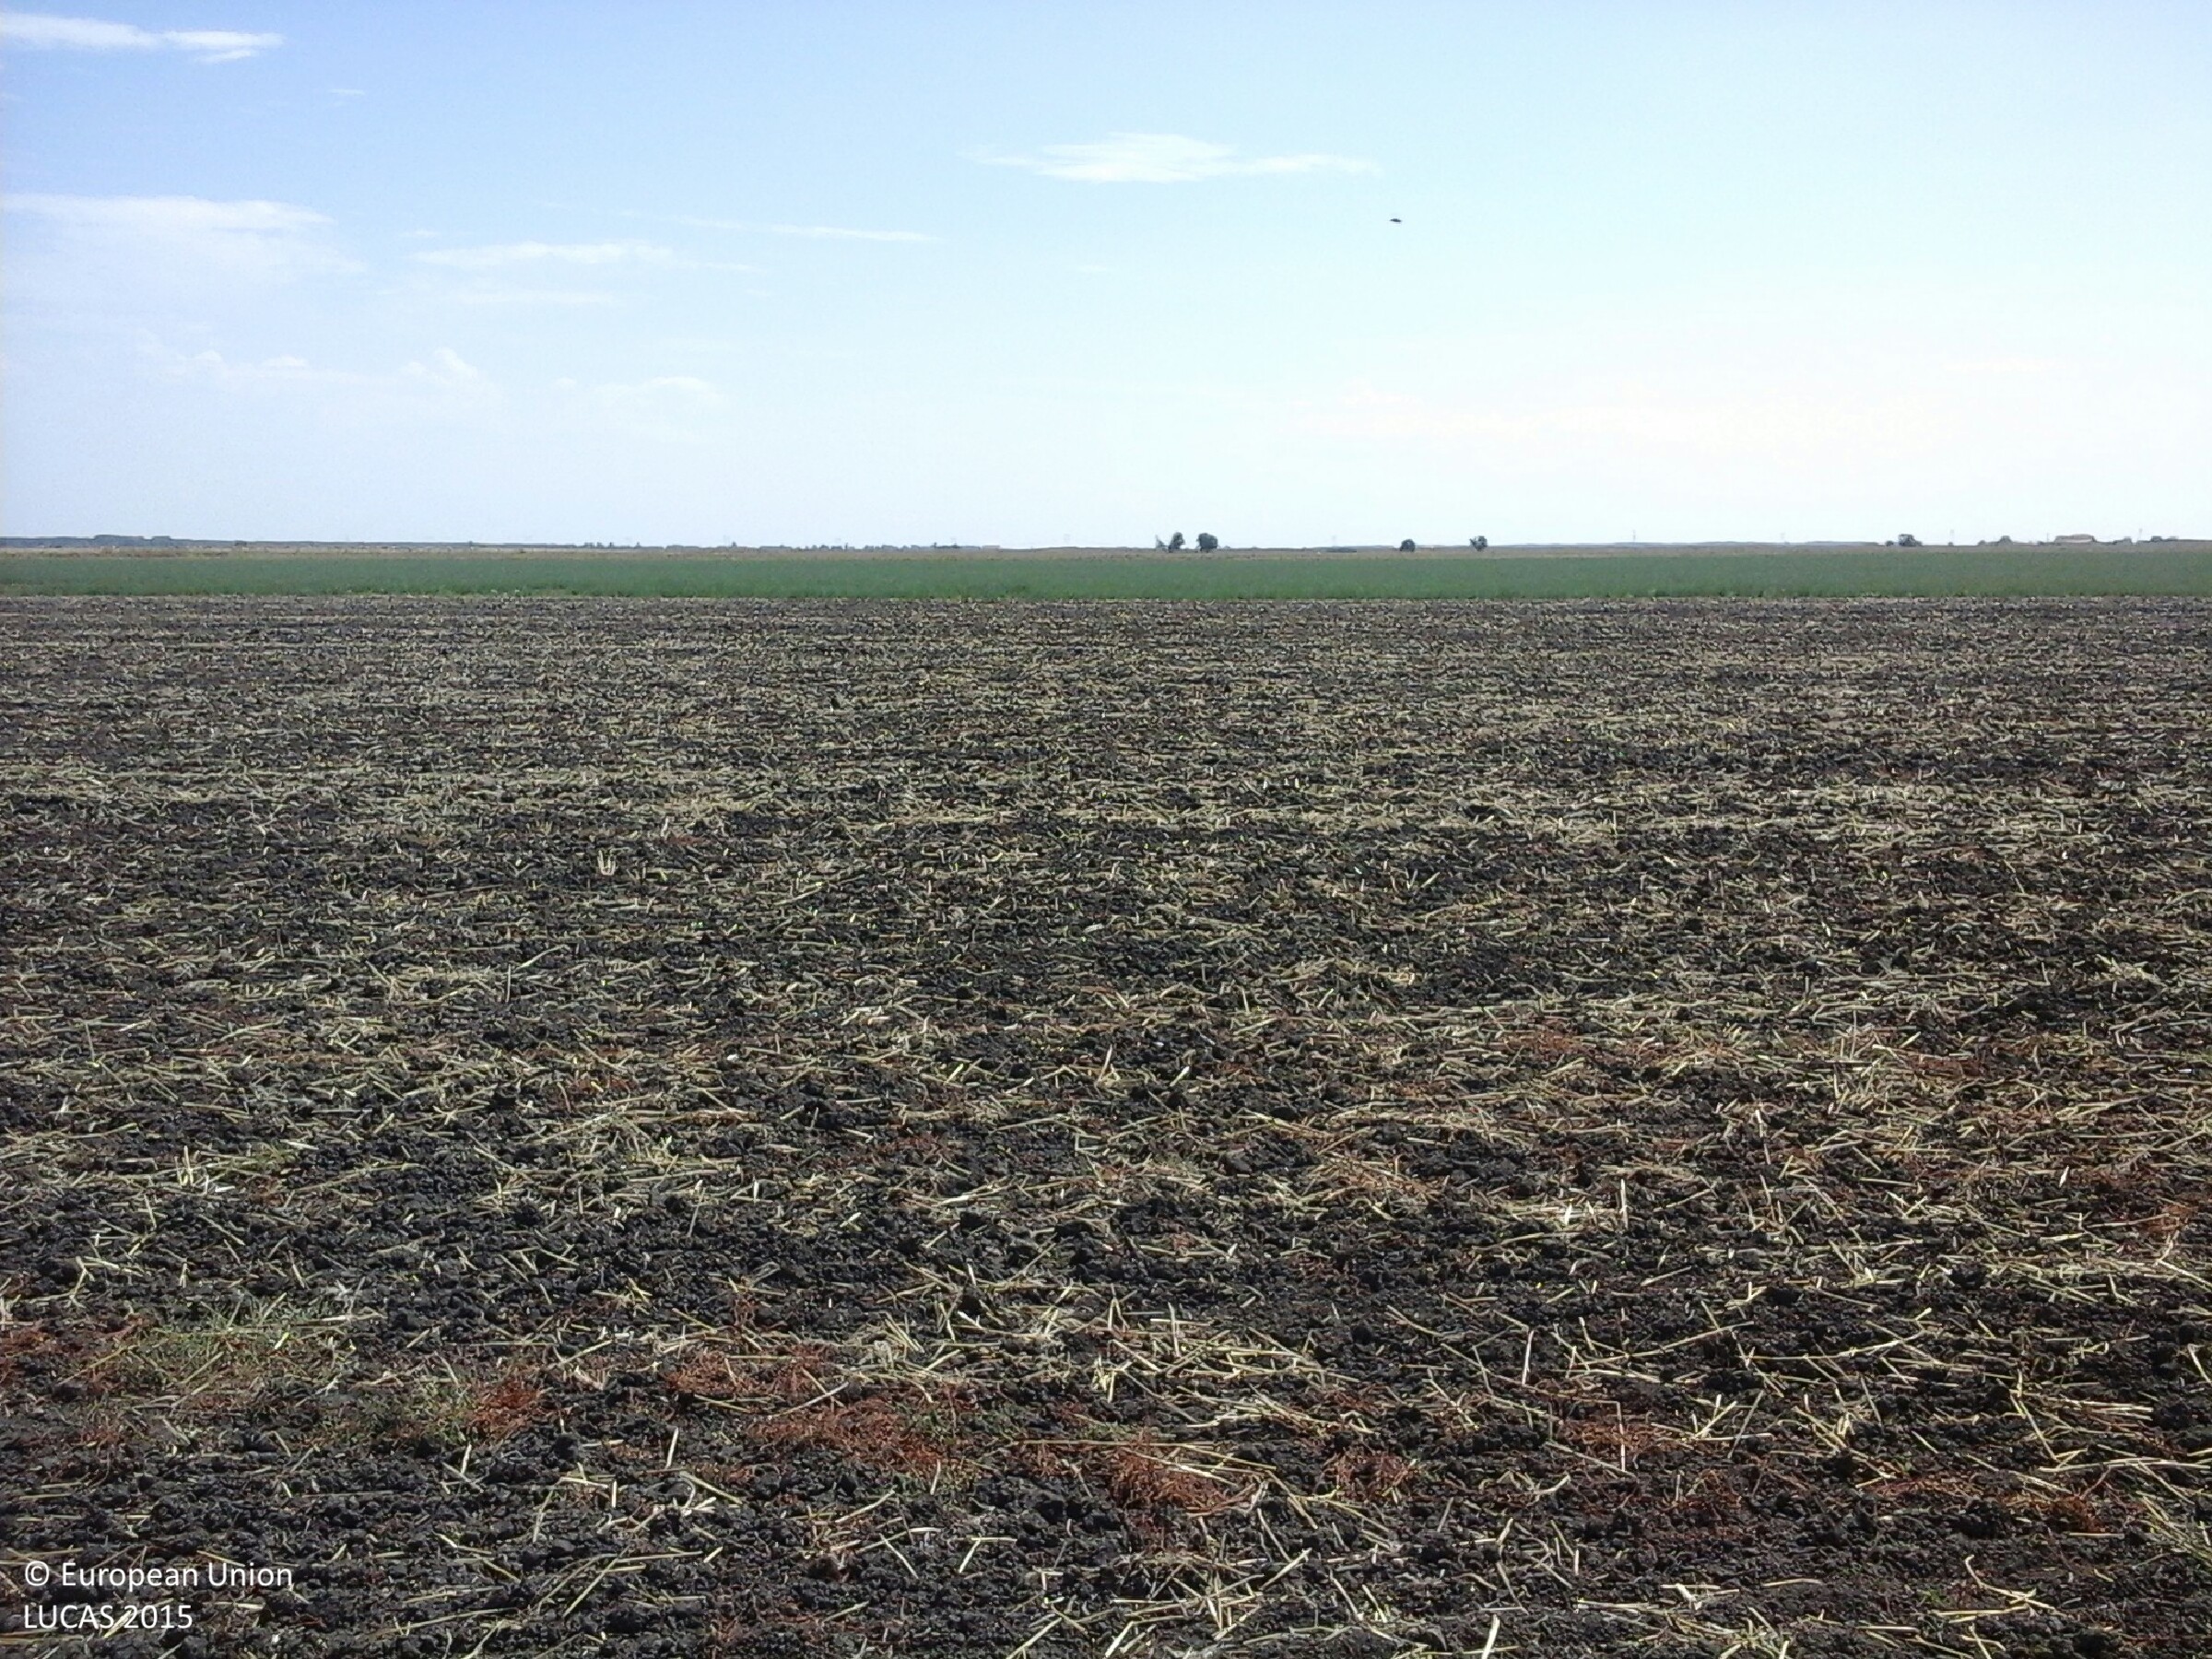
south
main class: Cropland
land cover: Common wheat
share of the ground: < 10 %
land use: Agriculture (excluding fallow land and kitchen gardens)
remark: Harvested field
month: August
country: HU
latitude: 47.3817
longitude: 20.9901
